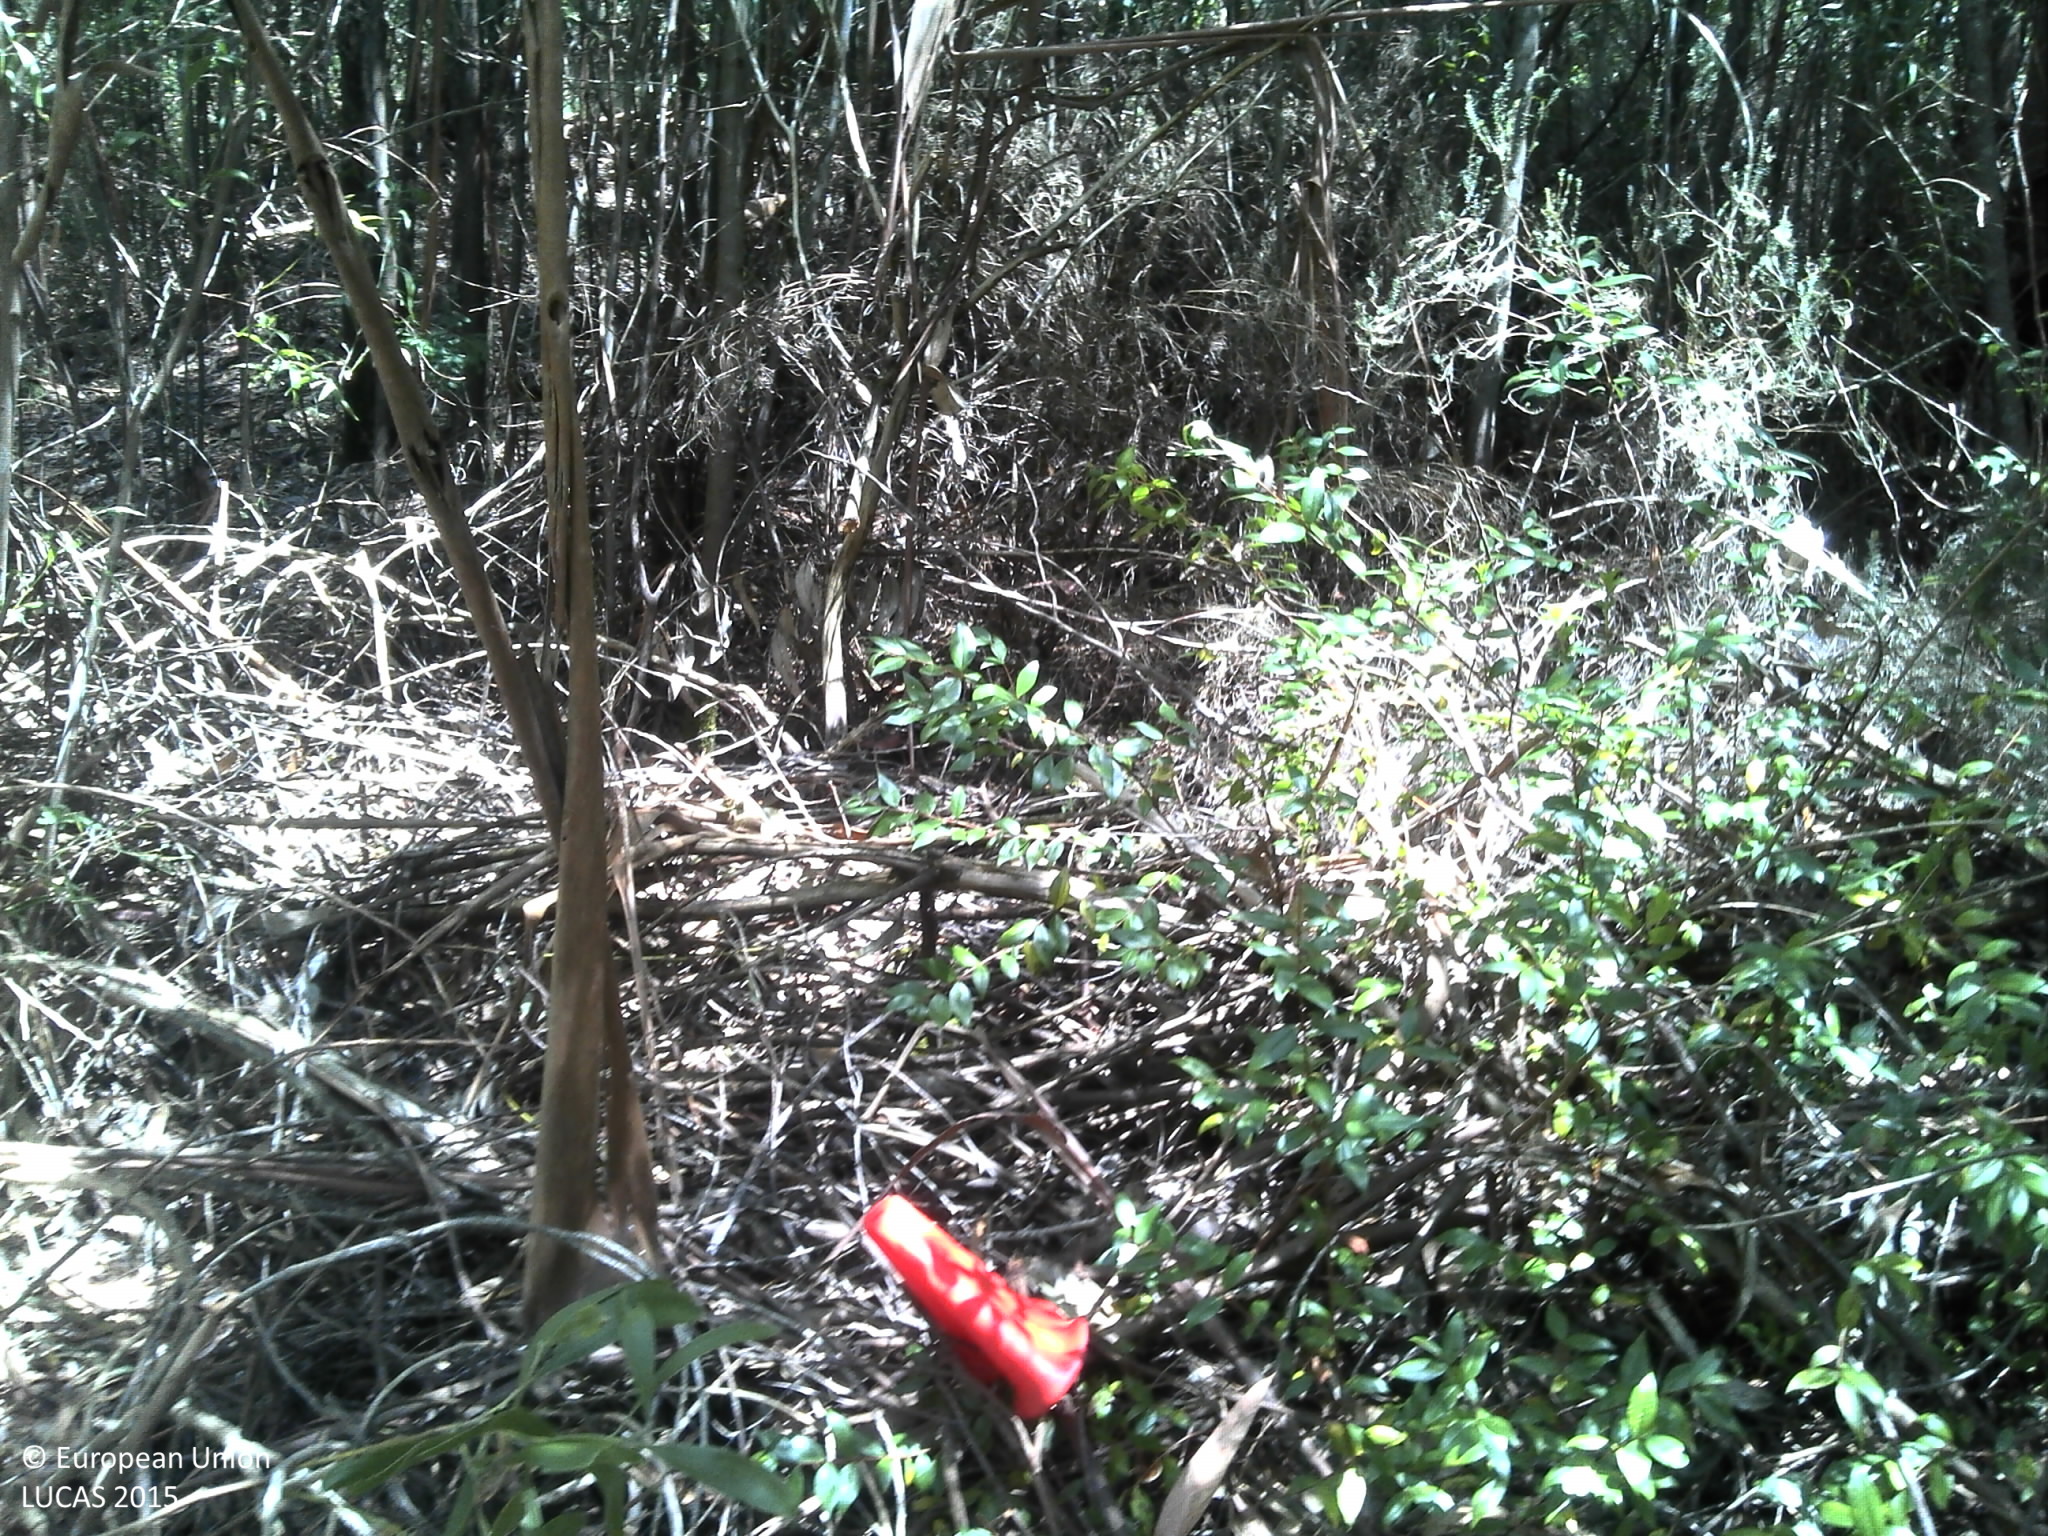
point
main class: Woodland
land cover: Broadleaved woodland
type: exotic forest
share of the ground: > 75 %
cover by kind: broadleaved forest trees 80 %, shrubs 10 %, herbaceous plants 5 %, unconsolidated bare surface 5 %
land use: Forestry
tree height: > 5 m
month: May
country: PT
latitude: 40.5131
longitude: -8.6602
